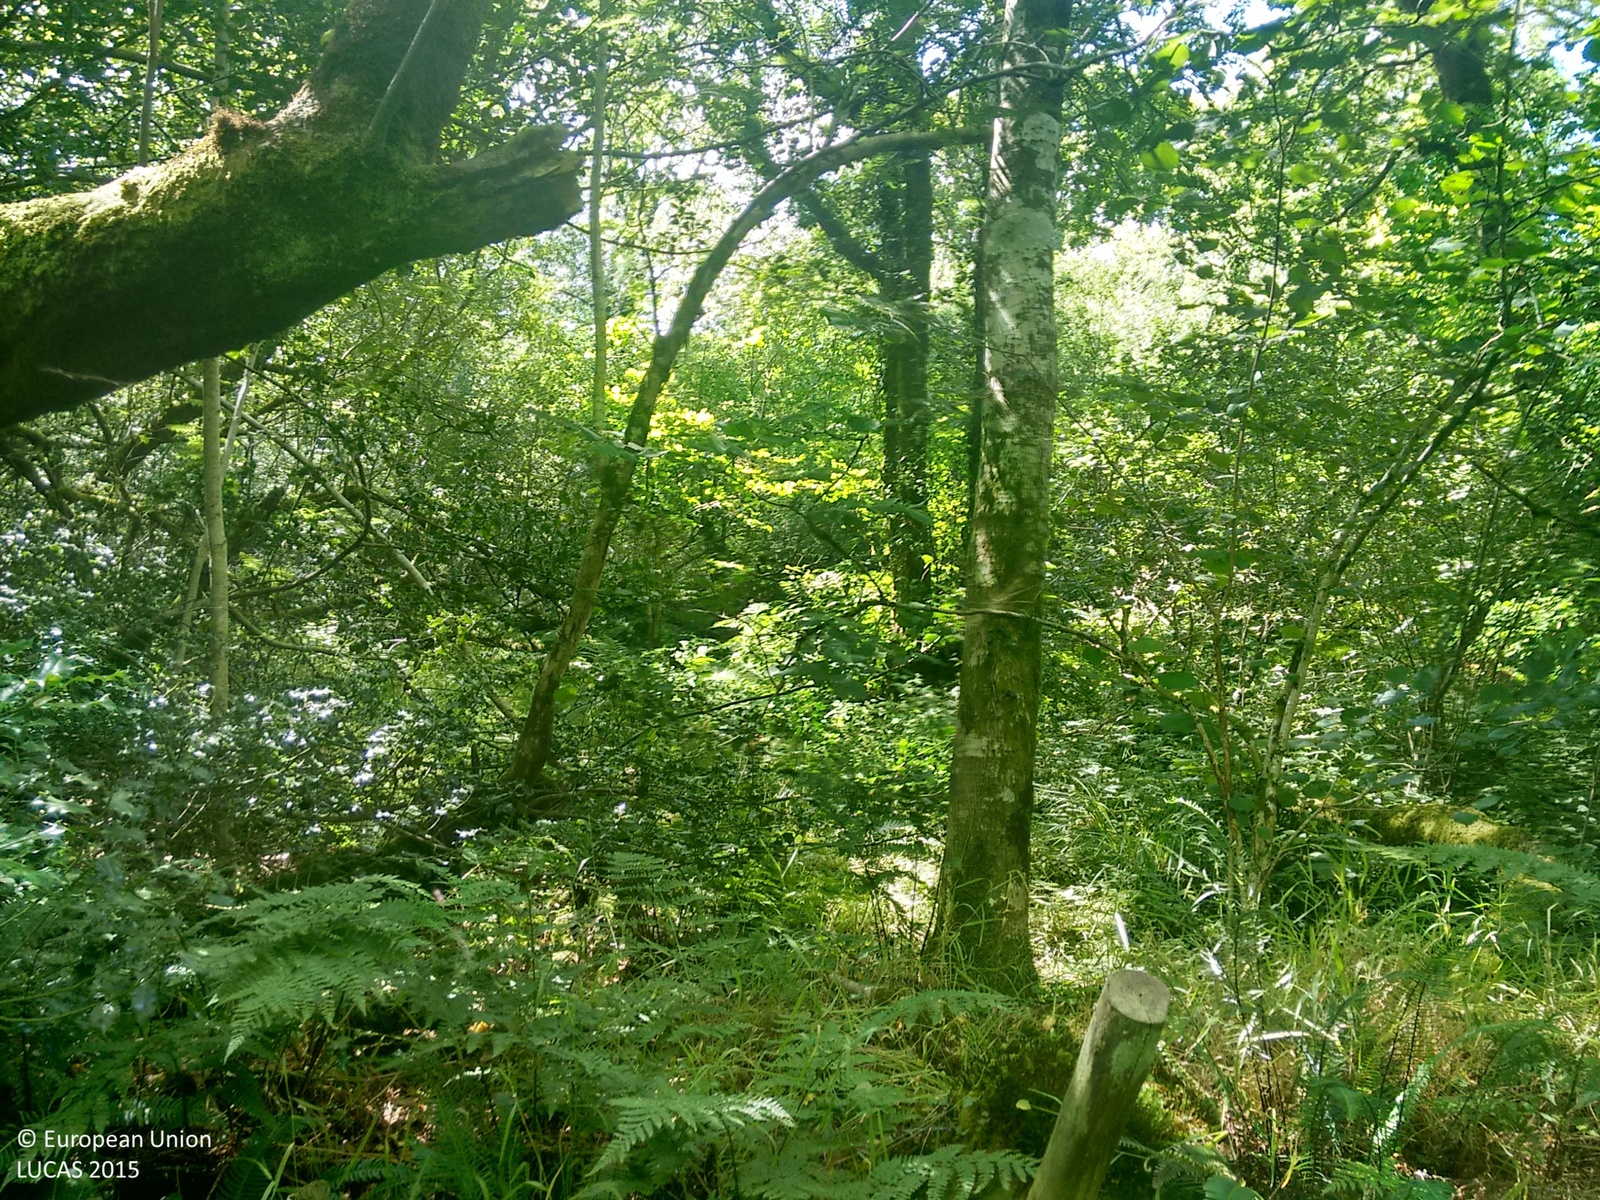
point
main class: Woodland
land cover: Broadleaved woodland
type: mesophytic deciduous forest
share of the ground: > 75 %
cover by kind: broadleaved forest trees 100 %
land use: Semi-natural and natural areas not in use
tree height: > 5 m
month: July
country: GB
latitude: 50.5805
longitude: -3.8026
